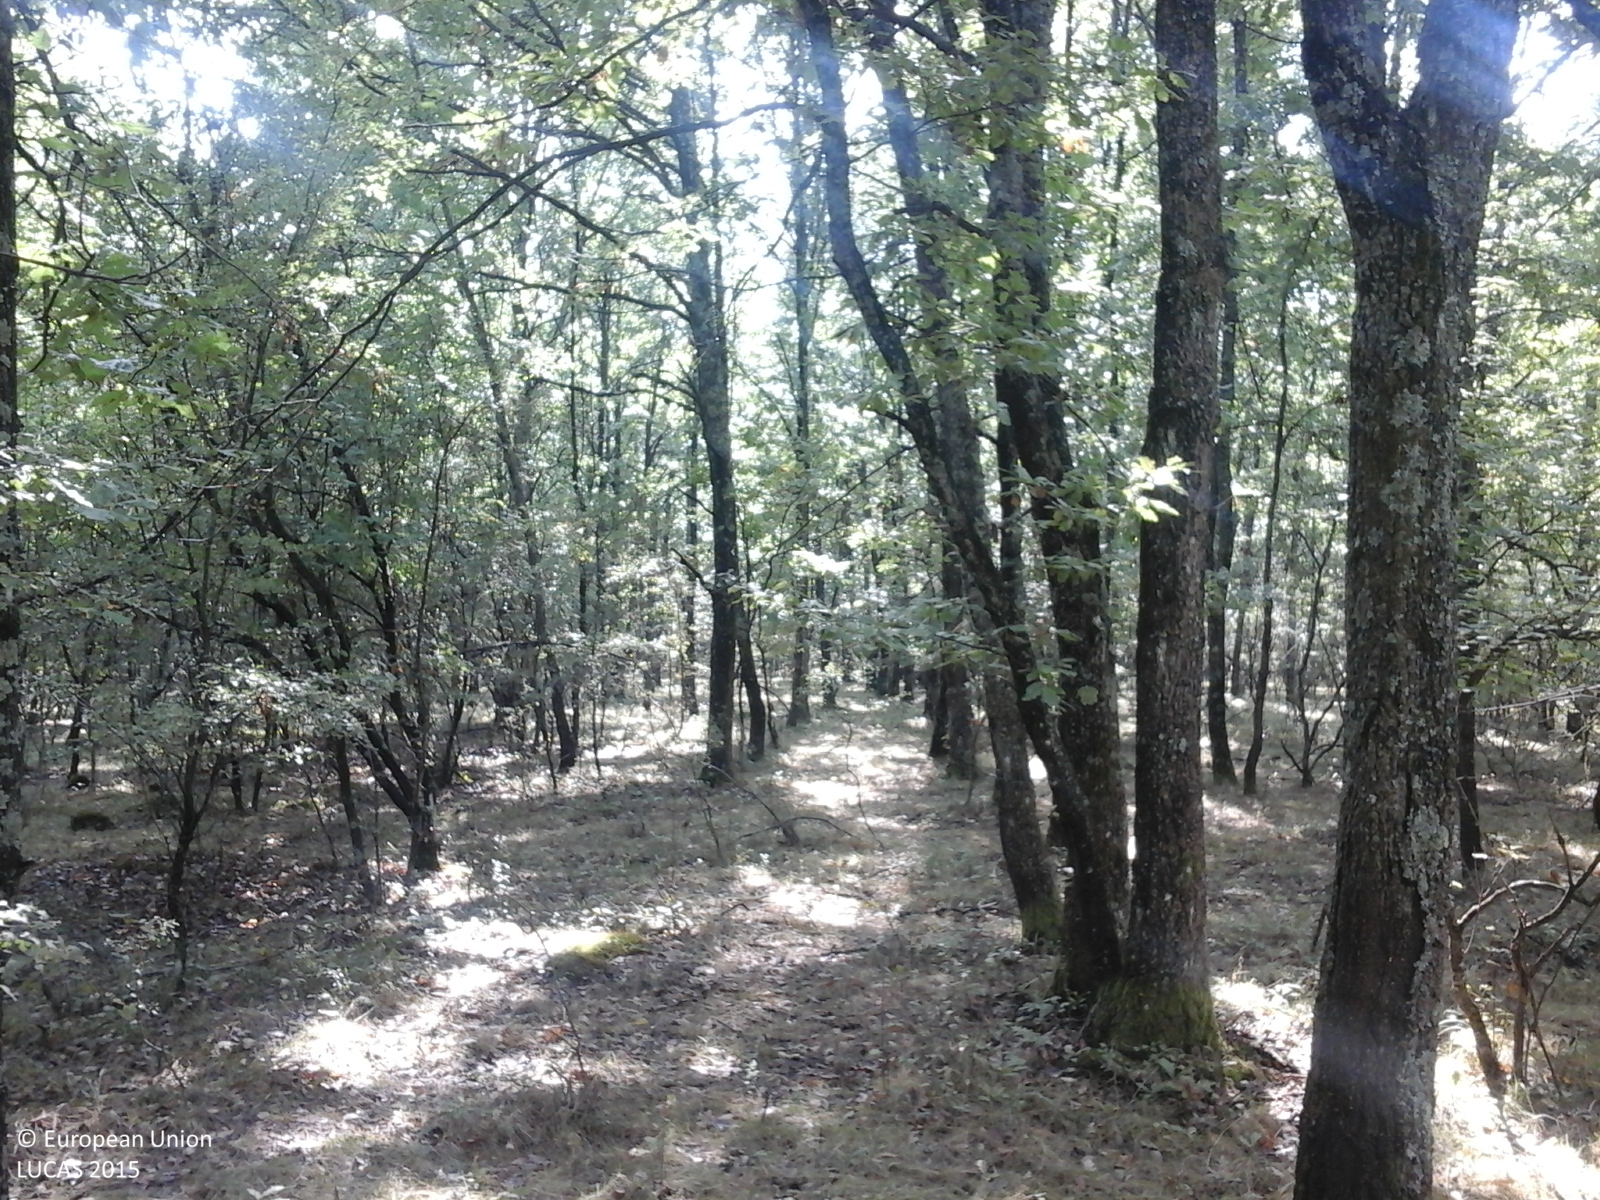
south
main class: Woodland
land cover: Broadleaved woodland
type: acidophilous oak and oak-birch forest
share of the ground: > 75 %
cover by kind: broadleaved forest trees 100 %
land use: Forestry
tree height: > 5 m
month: September
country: RO
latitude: 45.0855
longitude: 23.0993
